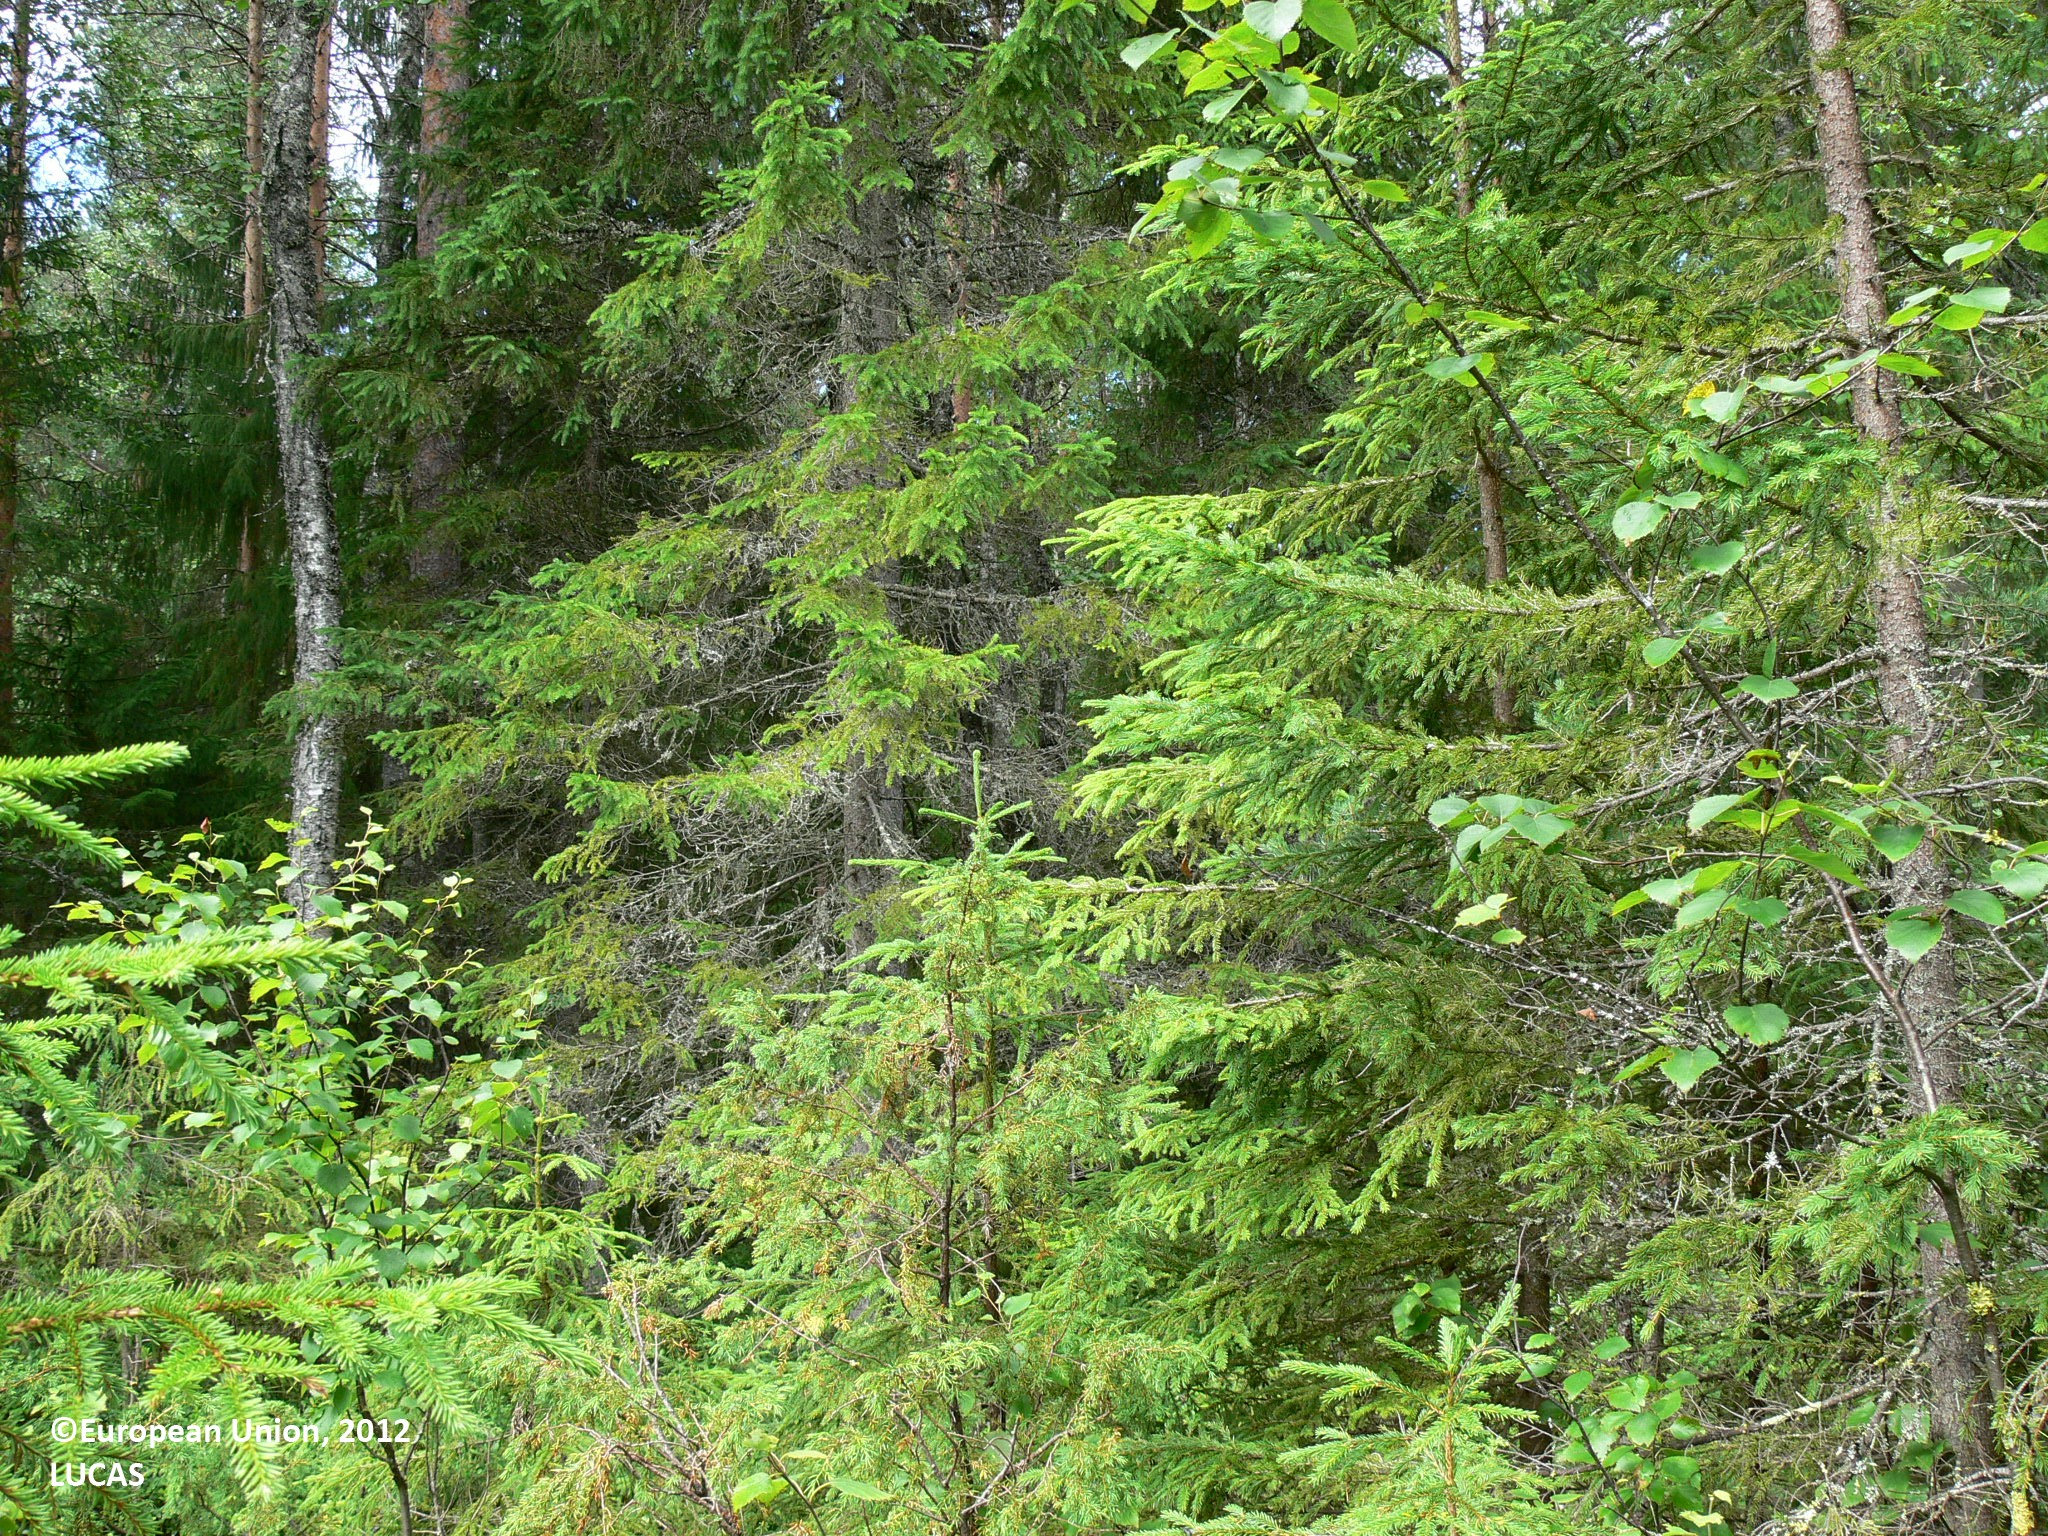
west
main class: Woodland
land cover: Spruce dominated coniferous woodland
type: boreal forest
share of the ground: 50 - 75 %
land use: Forestry
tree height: > 5 m
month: July
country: FI
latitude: 63.0872
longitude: 29.5418
